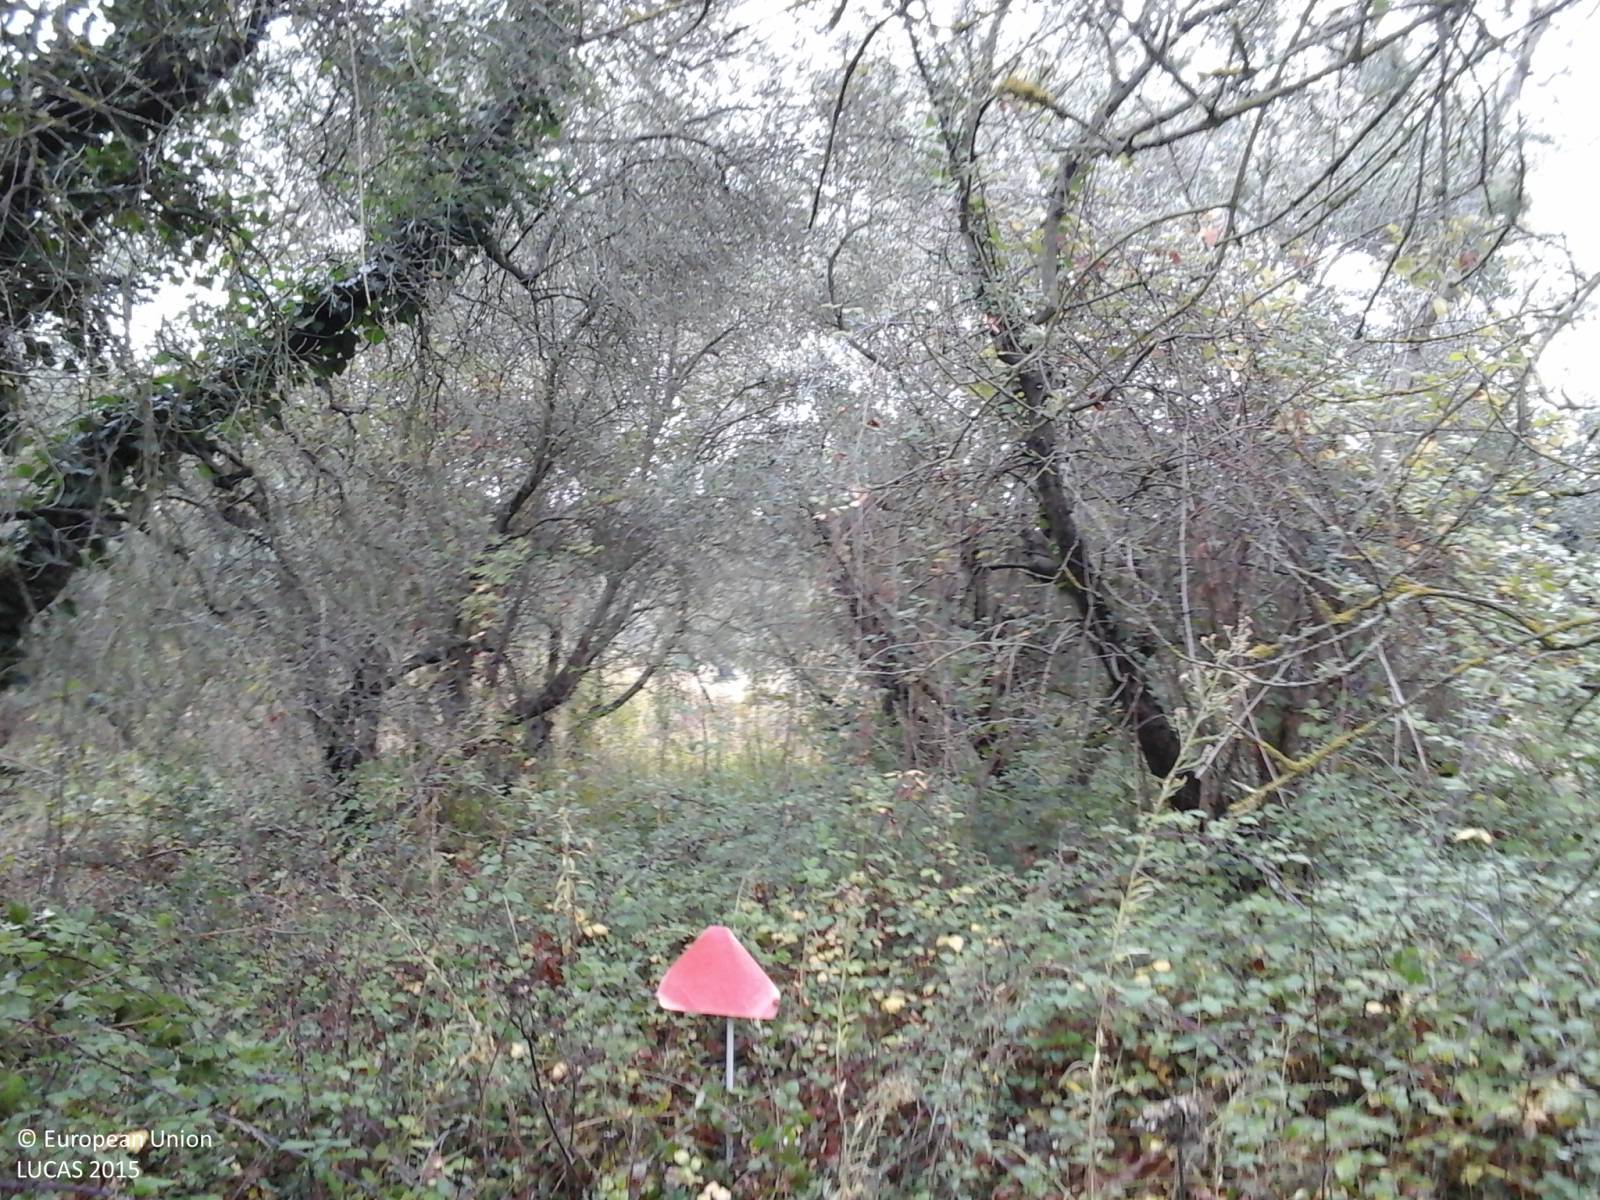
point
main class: Cropland
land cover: Olive groves
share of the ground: 50 - 75 %
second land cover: Shrubland without tree cover
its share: > 75 %
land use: Abandoned areas
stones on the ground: 10 - 25 %
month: October
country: IT
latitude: 43.0652
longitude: 10.9181
